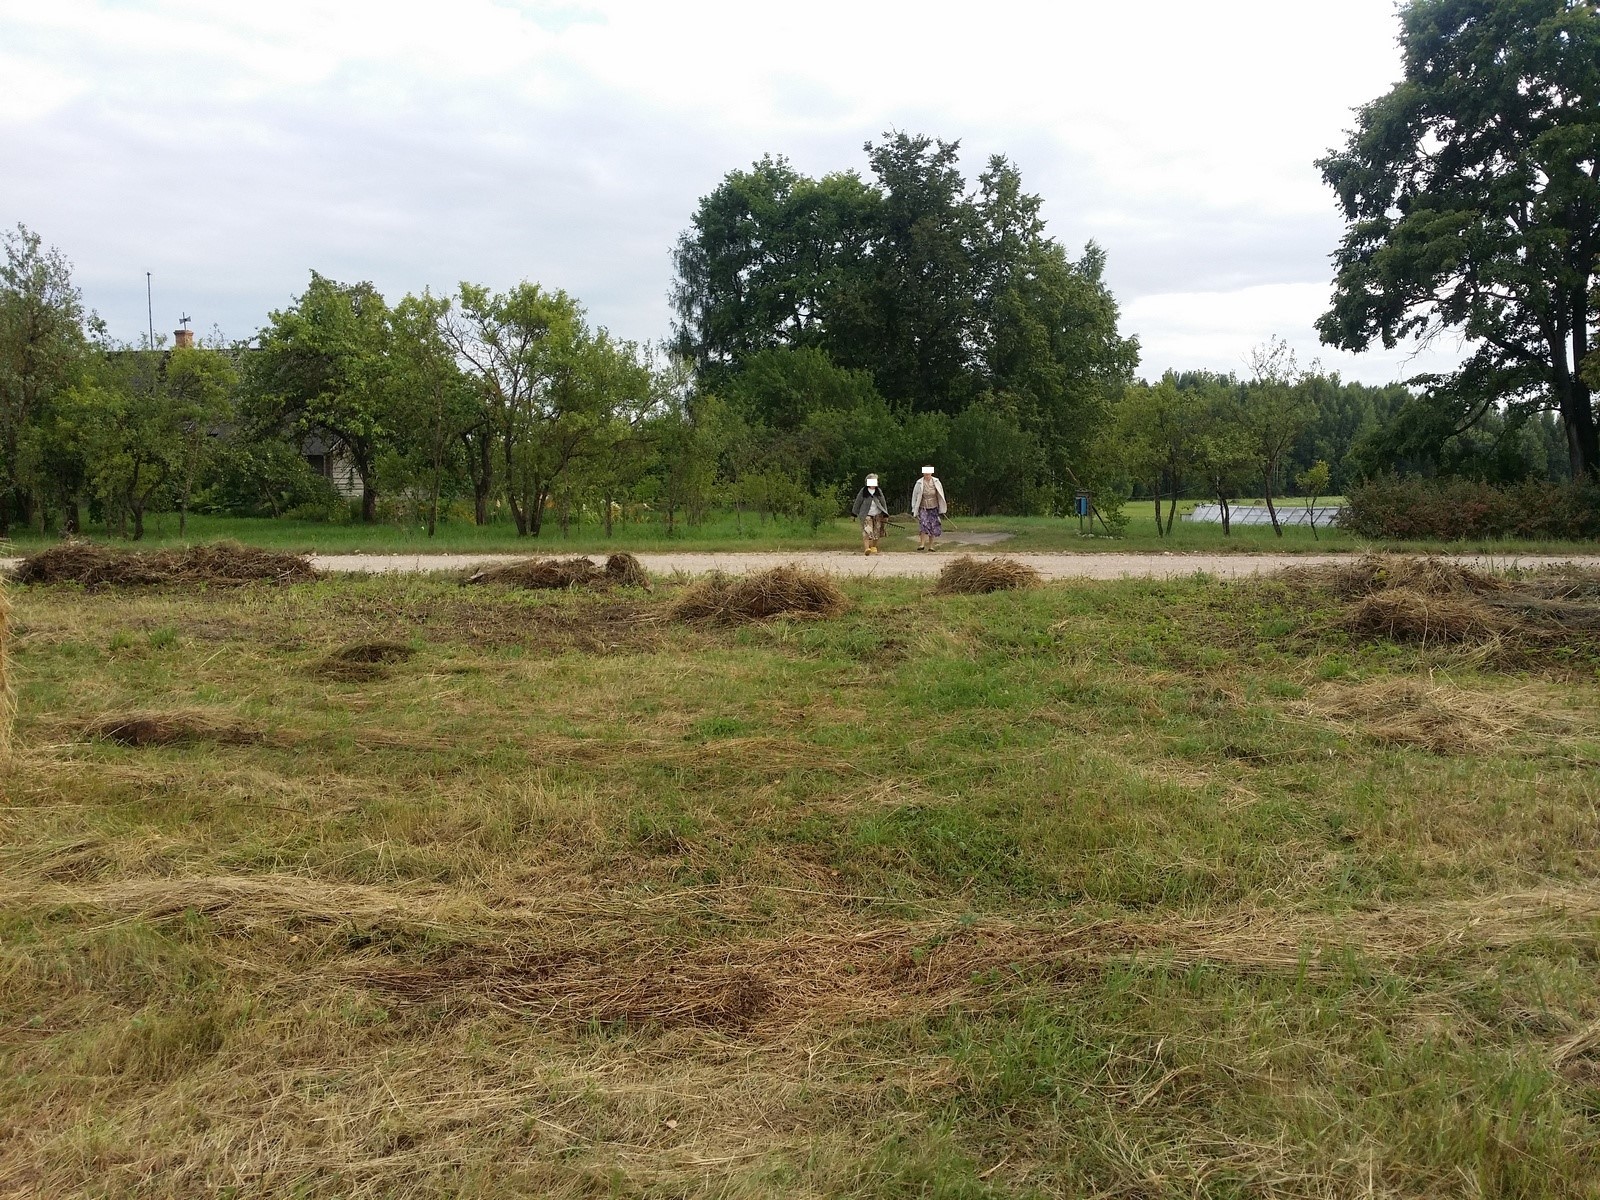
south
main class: Grassland
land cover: Grassland without tree/shrub cover
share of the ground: > 75 %
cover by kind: herbaceous plants 90 %, unconsolidated bare surface 10 %
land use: Agriculture (excluding fallow land and kitchen gardens)
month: August
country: LV
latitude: 56.9474
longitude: 27.2155
